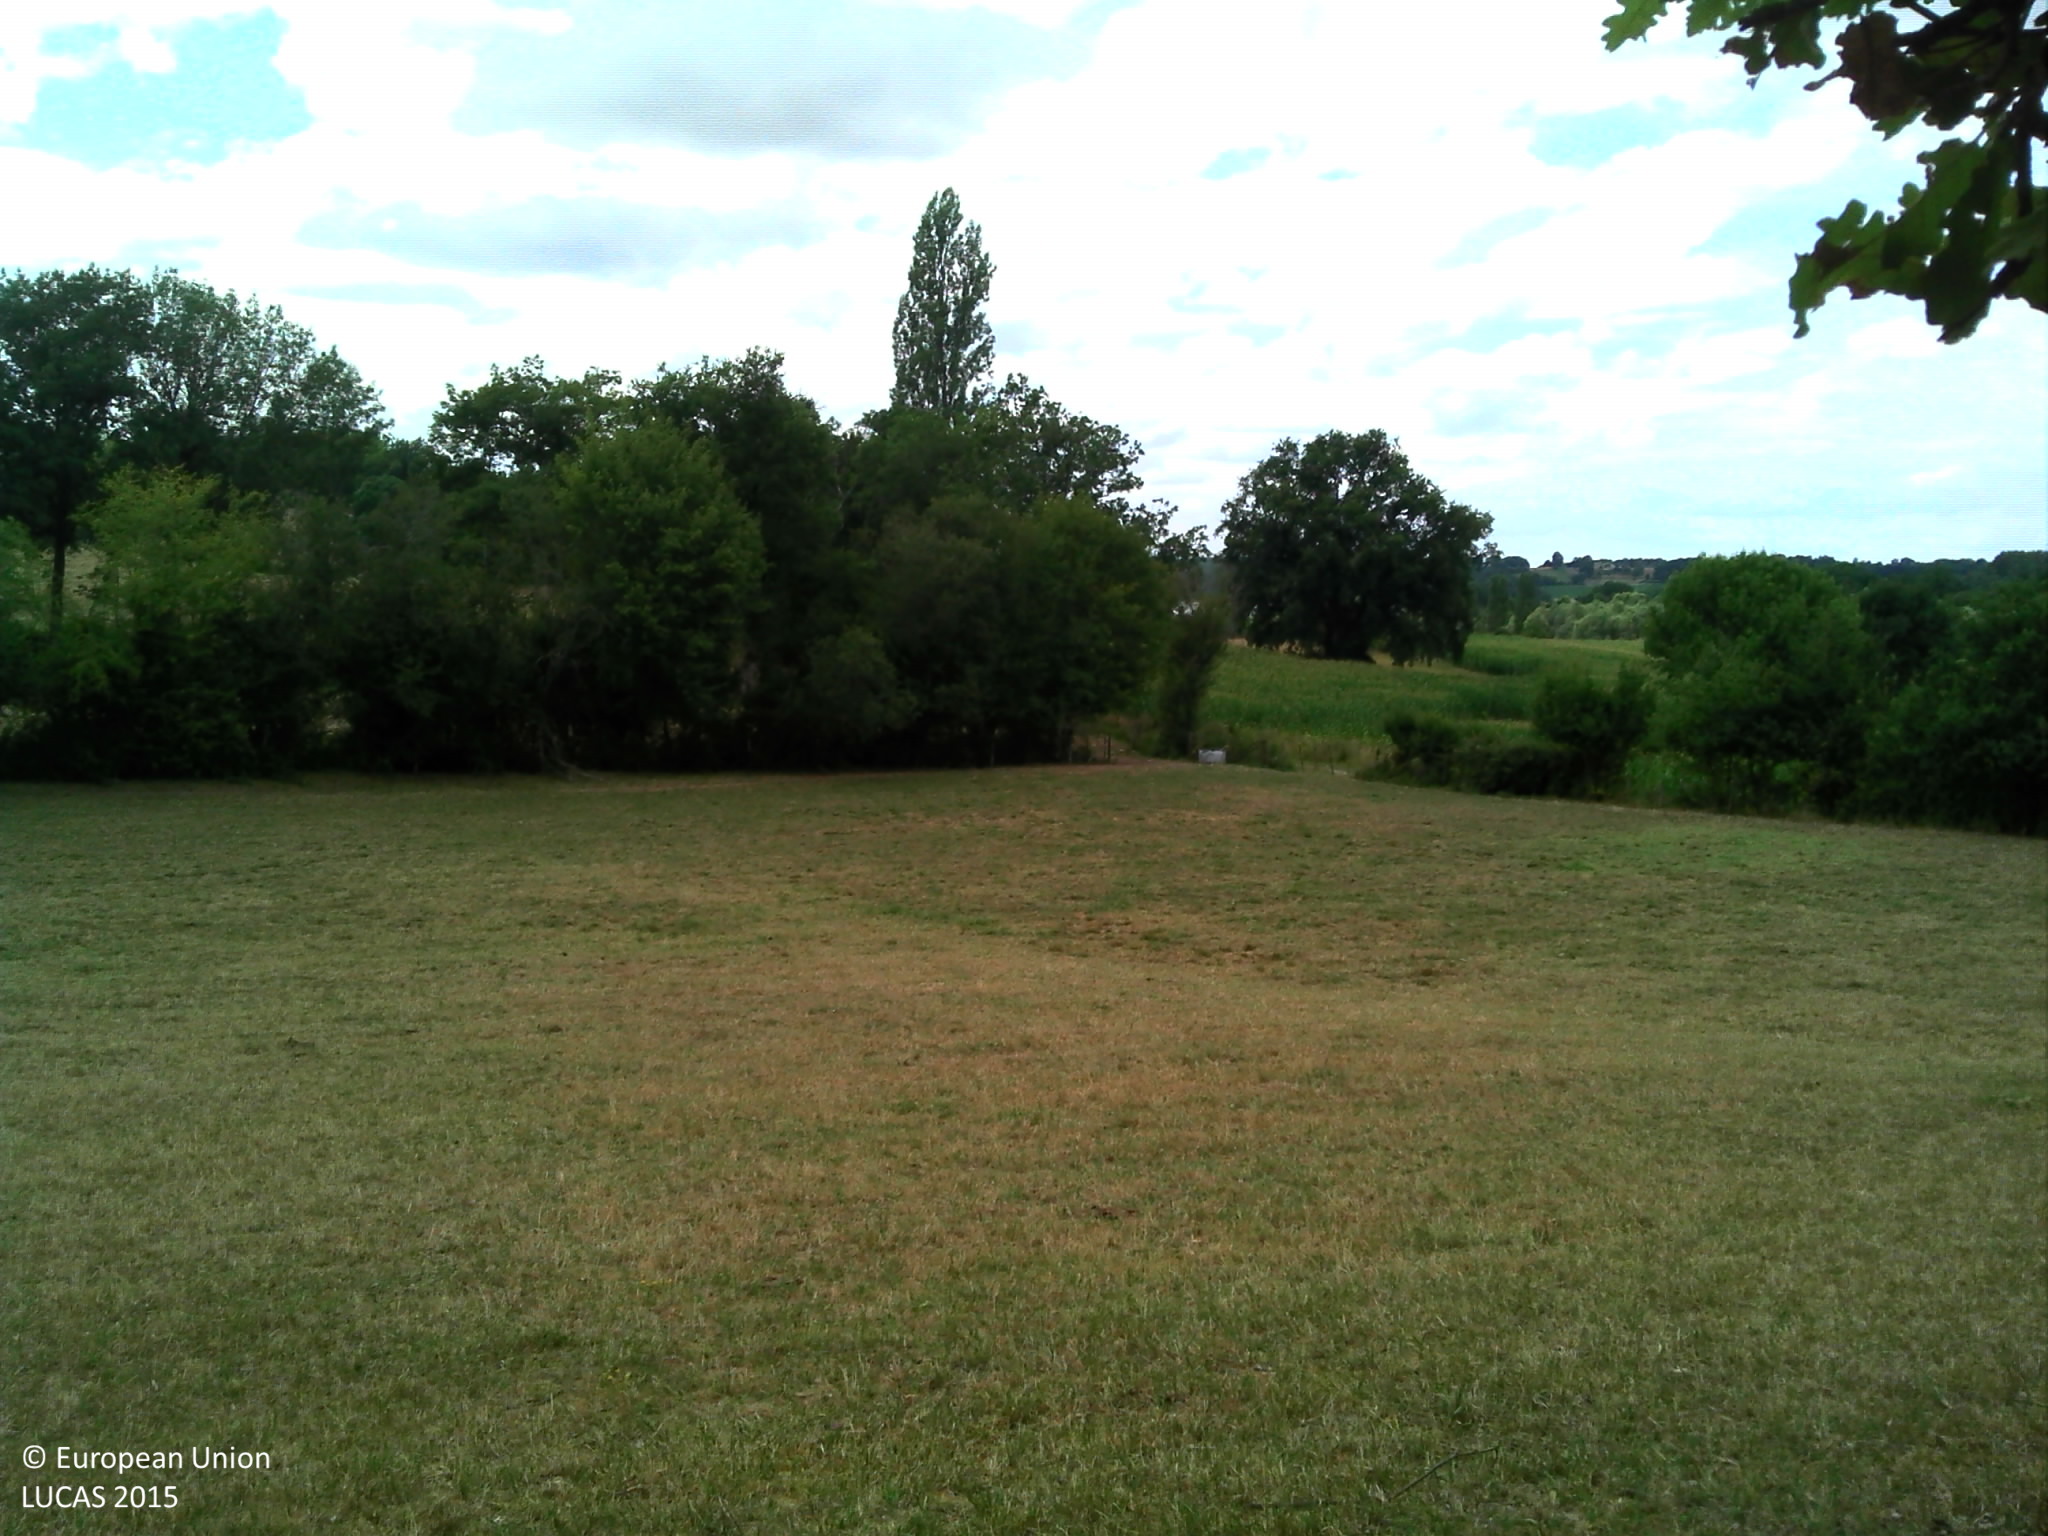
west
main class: Woodland
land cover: Broadleaved woodland
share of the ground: > 75 %
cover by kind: broadleaved forest trees 80 %, shrubs 20 %
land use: Agriculture (excluding fallow land and kitchen gardens)
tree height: > 5 m
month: July
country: FR
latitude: 44.6688
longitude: 0.8235
